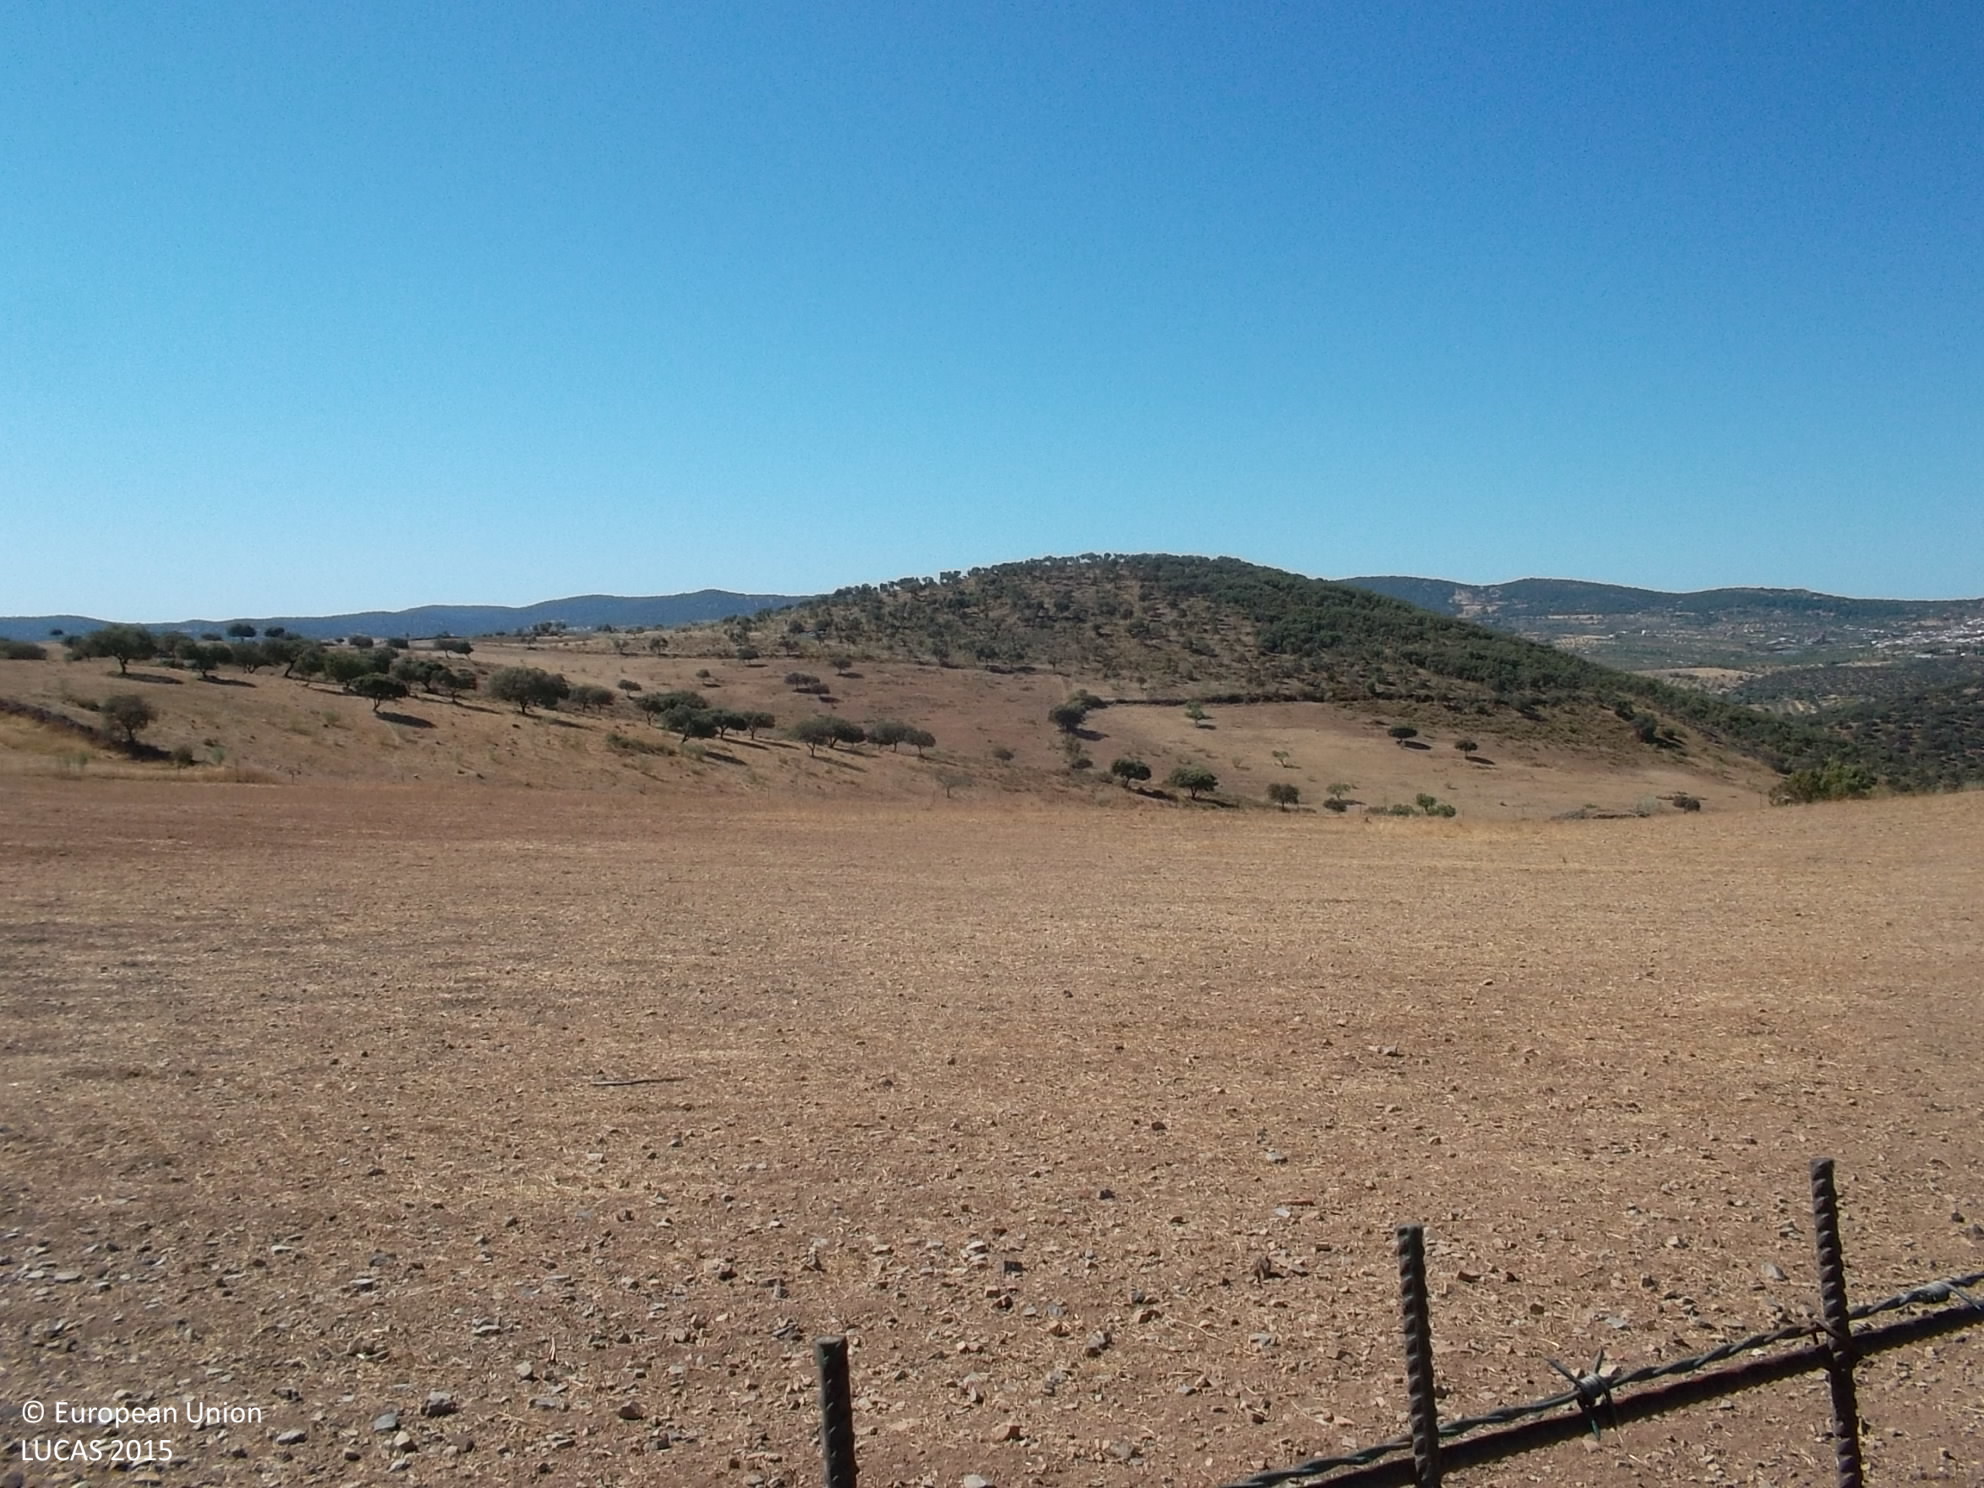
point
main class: Grassland
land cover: Grassland with sparse tree/shrub cover
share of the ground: > 75 %
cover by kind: herbaceous plants 90 %, broadleaved forest trees 5 %, shrubs 5 %
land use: Agriculture (excluding fallow land and kitchen gardens)
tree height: < 5 m
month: August
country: ES
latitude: 38.5194
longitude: -6.6530
